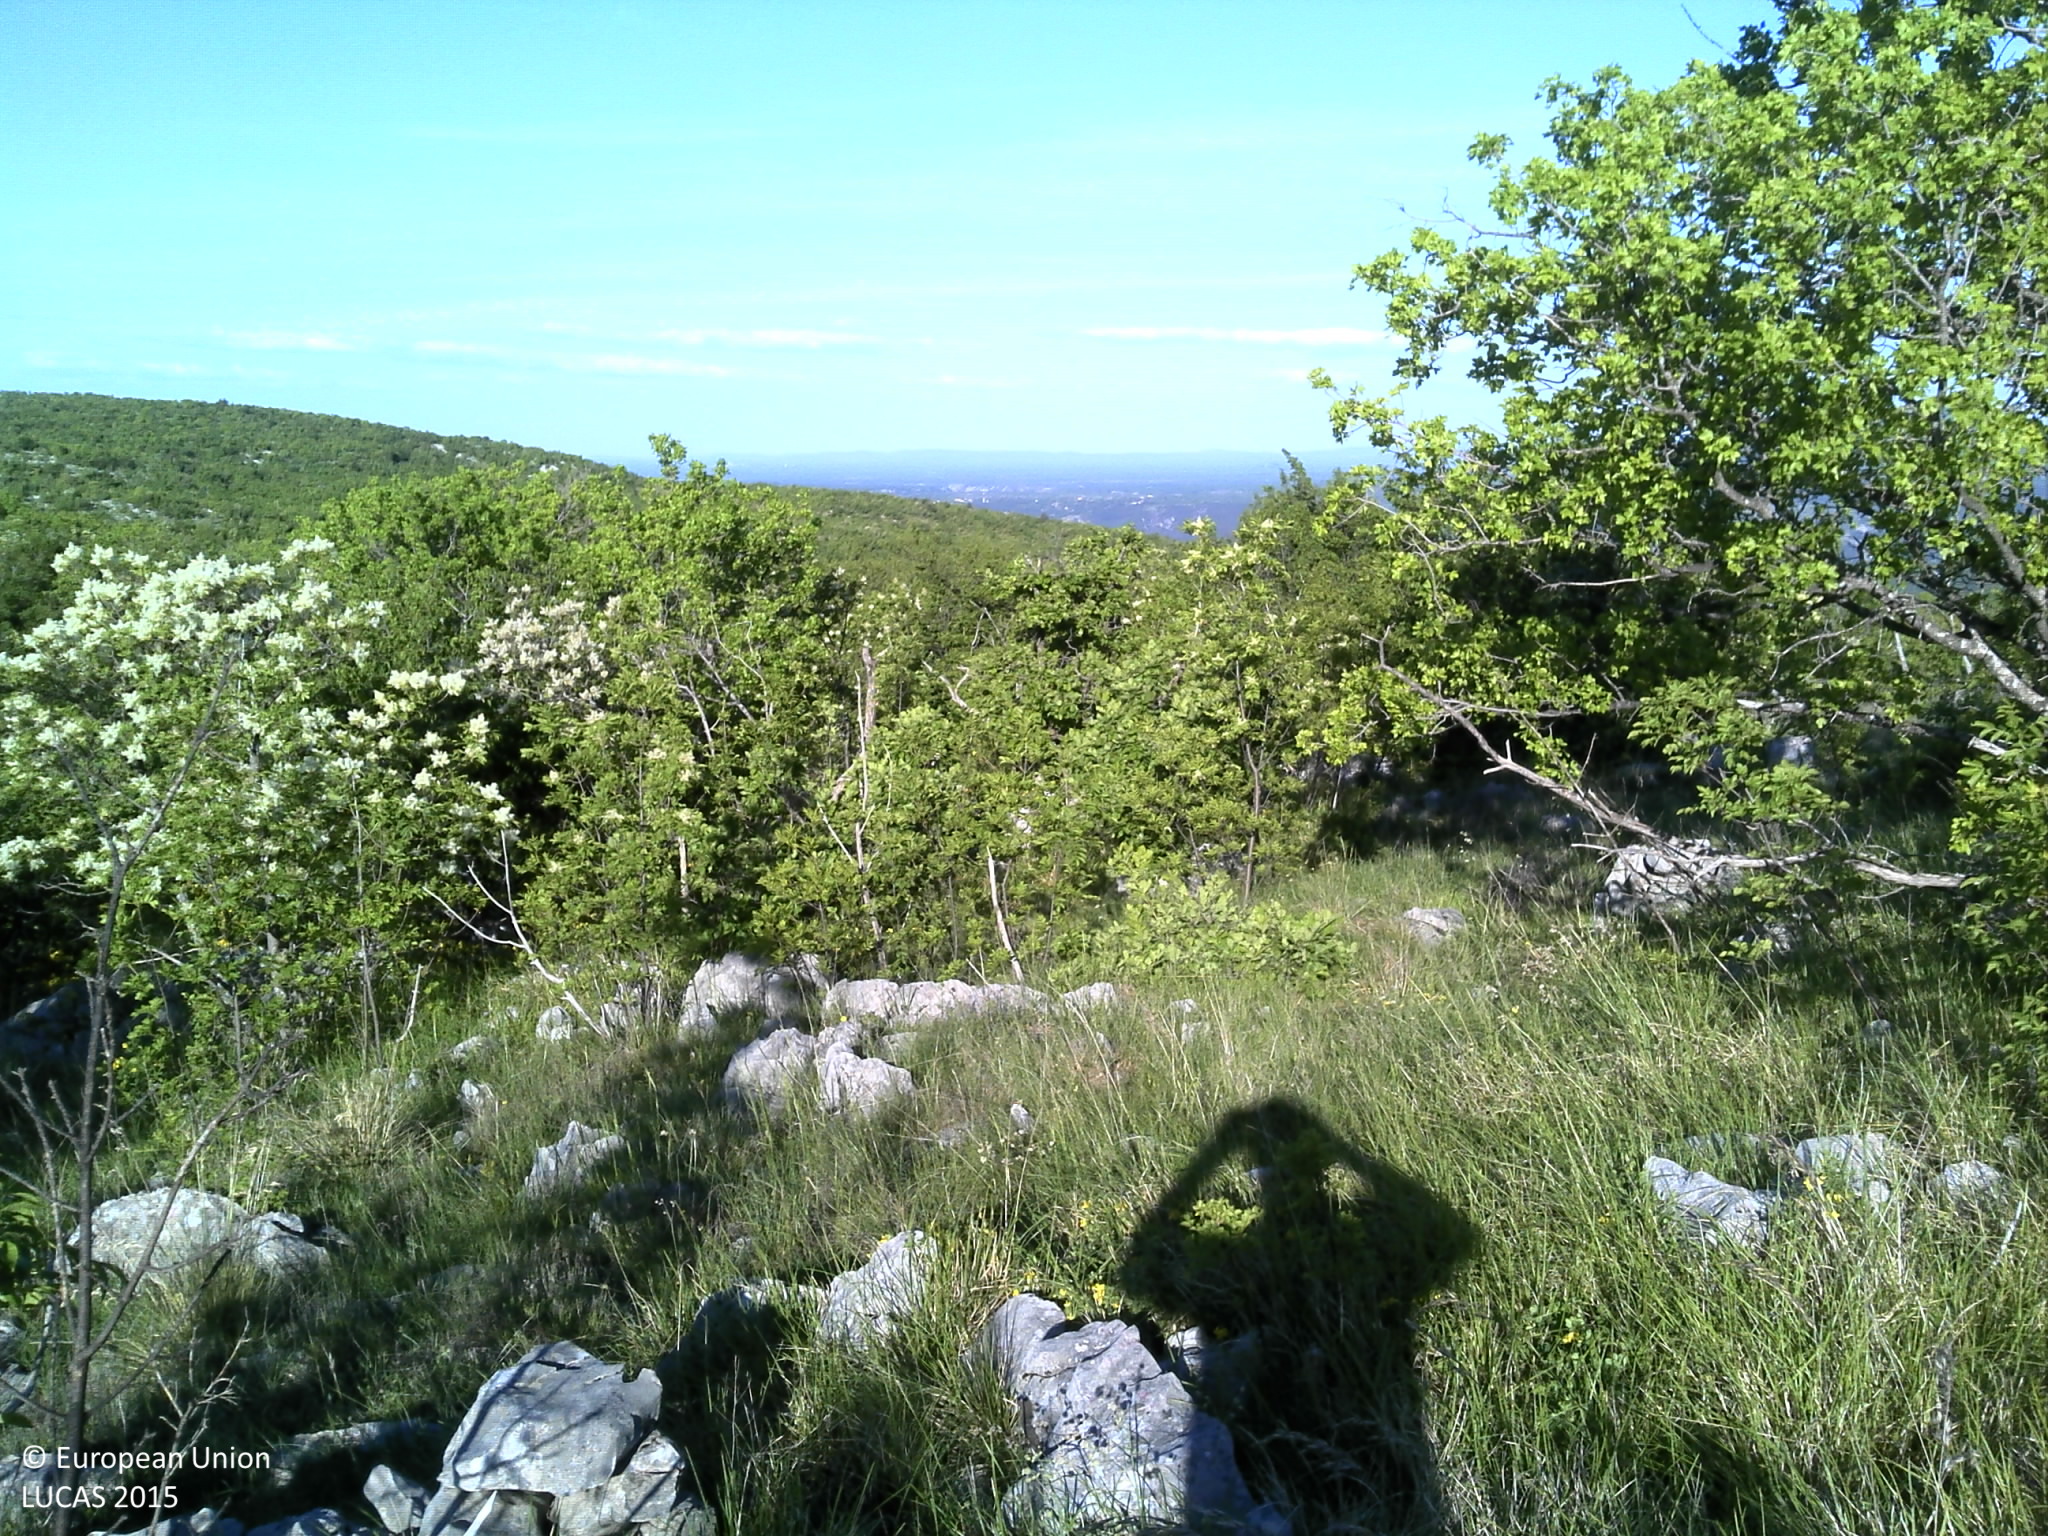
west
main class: Woodland
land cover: Broadleaved woodland
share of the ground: 10 - 25 %
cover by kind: shrubs 30 %, herbaceous plants 25 %, unconsolidated bare surface 20 %, broadleaved forest trees 15 %, lichens and mosses 5 %, consolidated bare surface 5 %
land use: Semi-natural and natural areas not in use
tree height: > 5 m
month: May
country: HR
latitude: 44.0703
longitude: 16.2730
